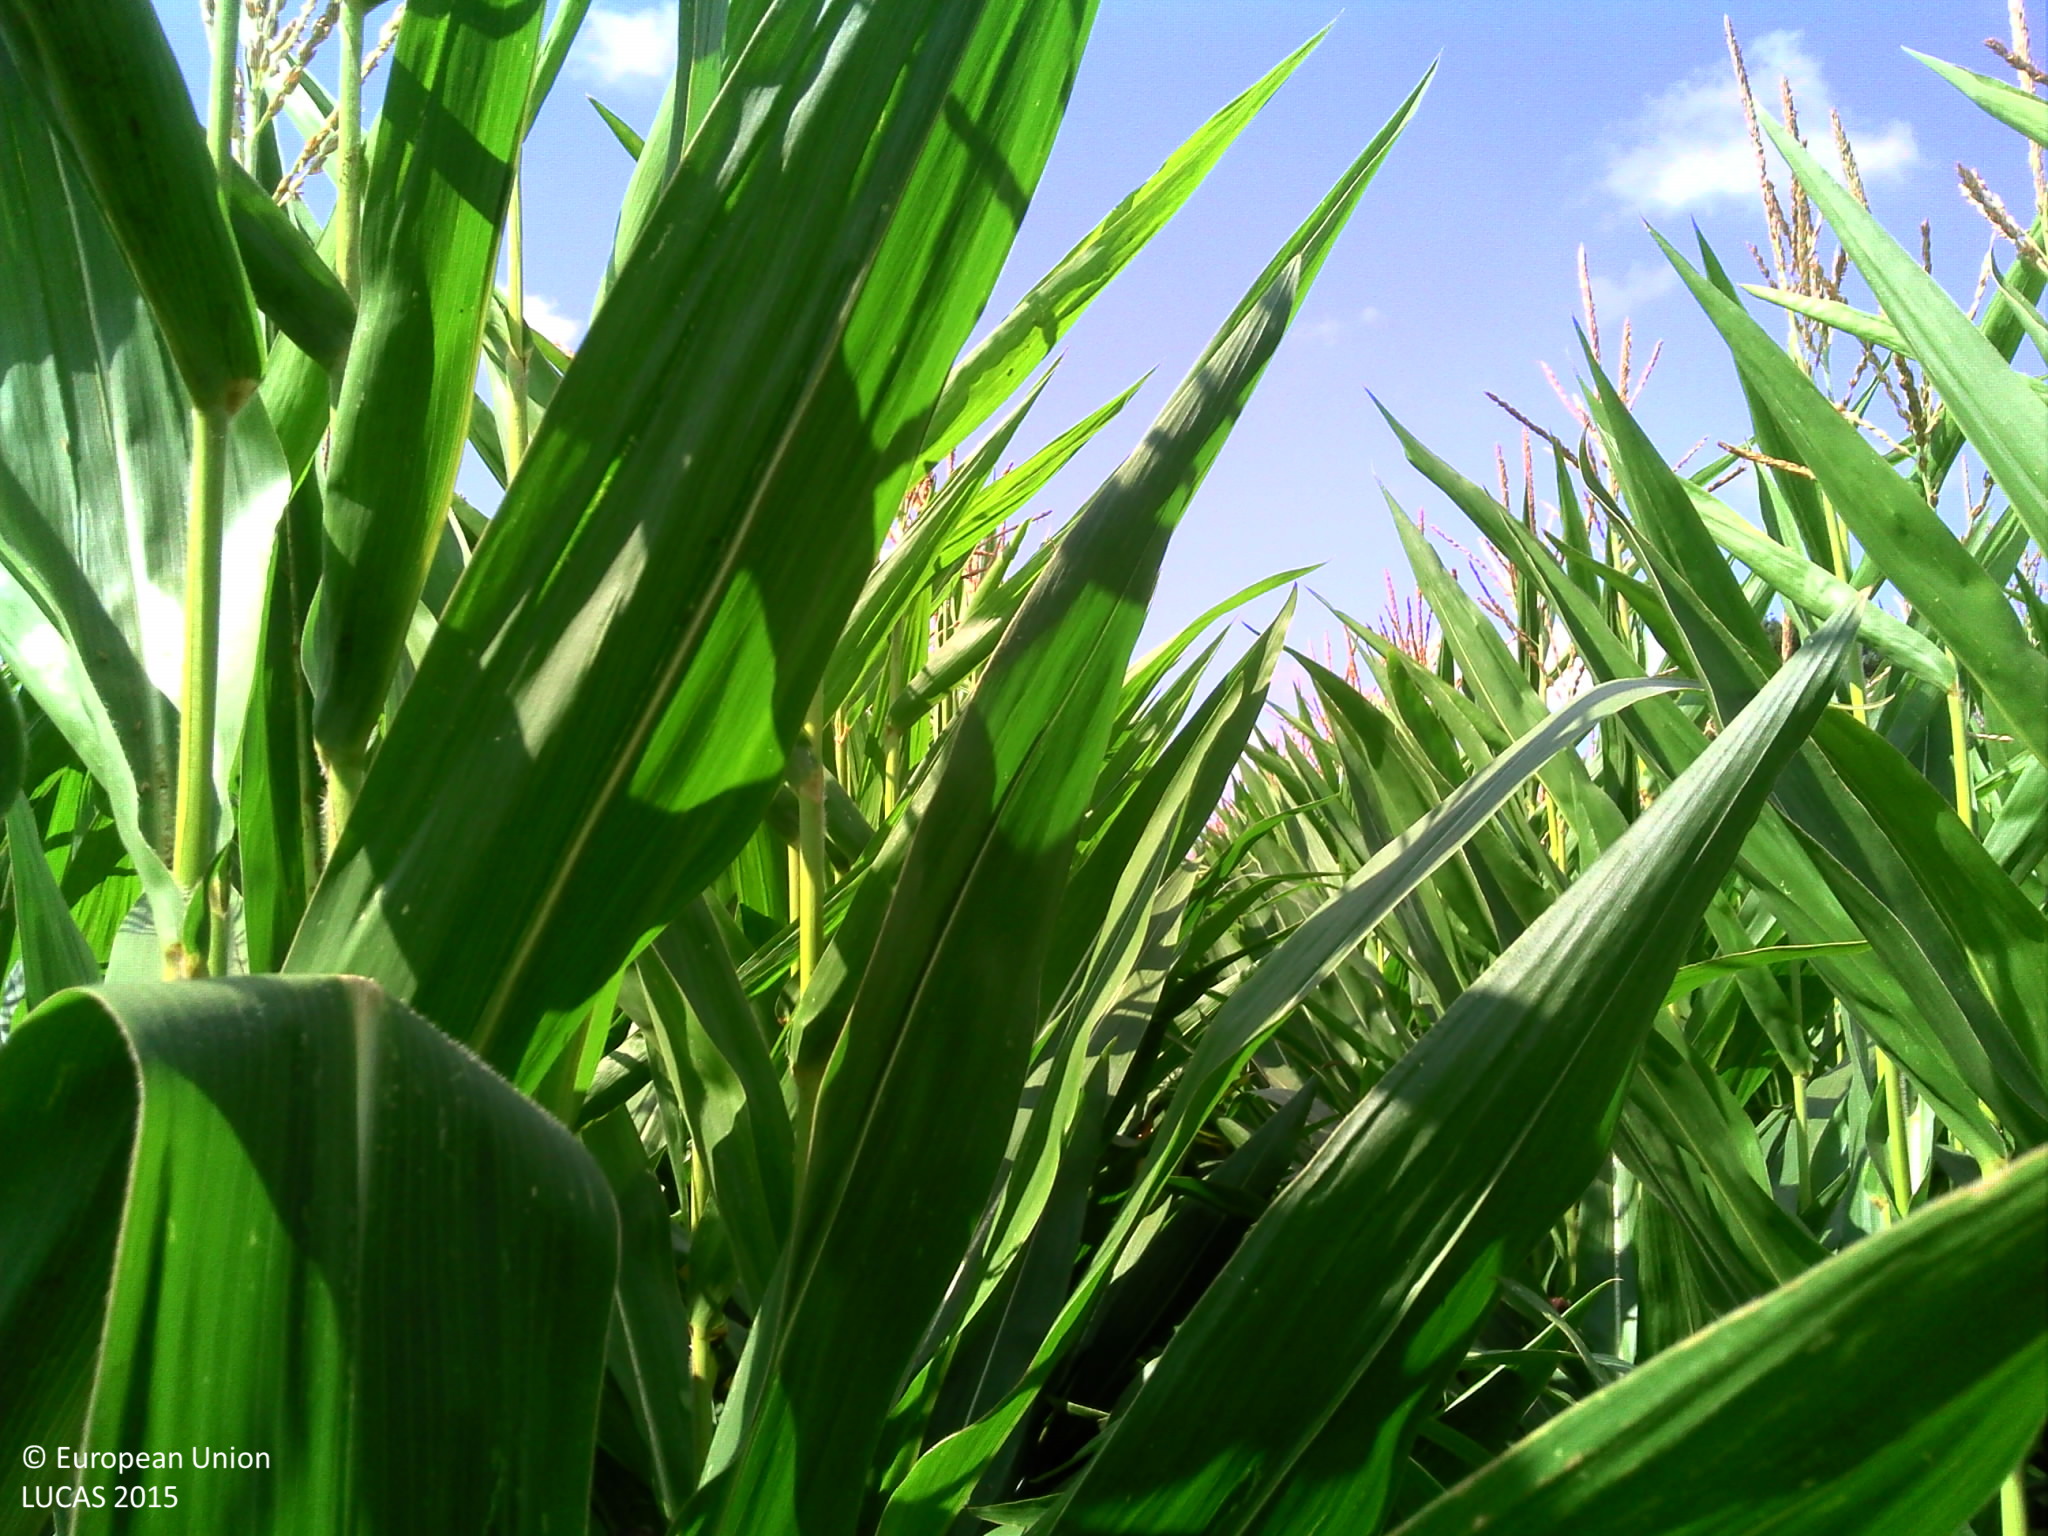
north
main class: Cropland
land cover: Maize
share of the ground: > 75 %
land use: Agriculture (excluding fallow land and kitchen gardens)
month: August
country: FR
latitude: 48.3156
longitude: -2.1242
